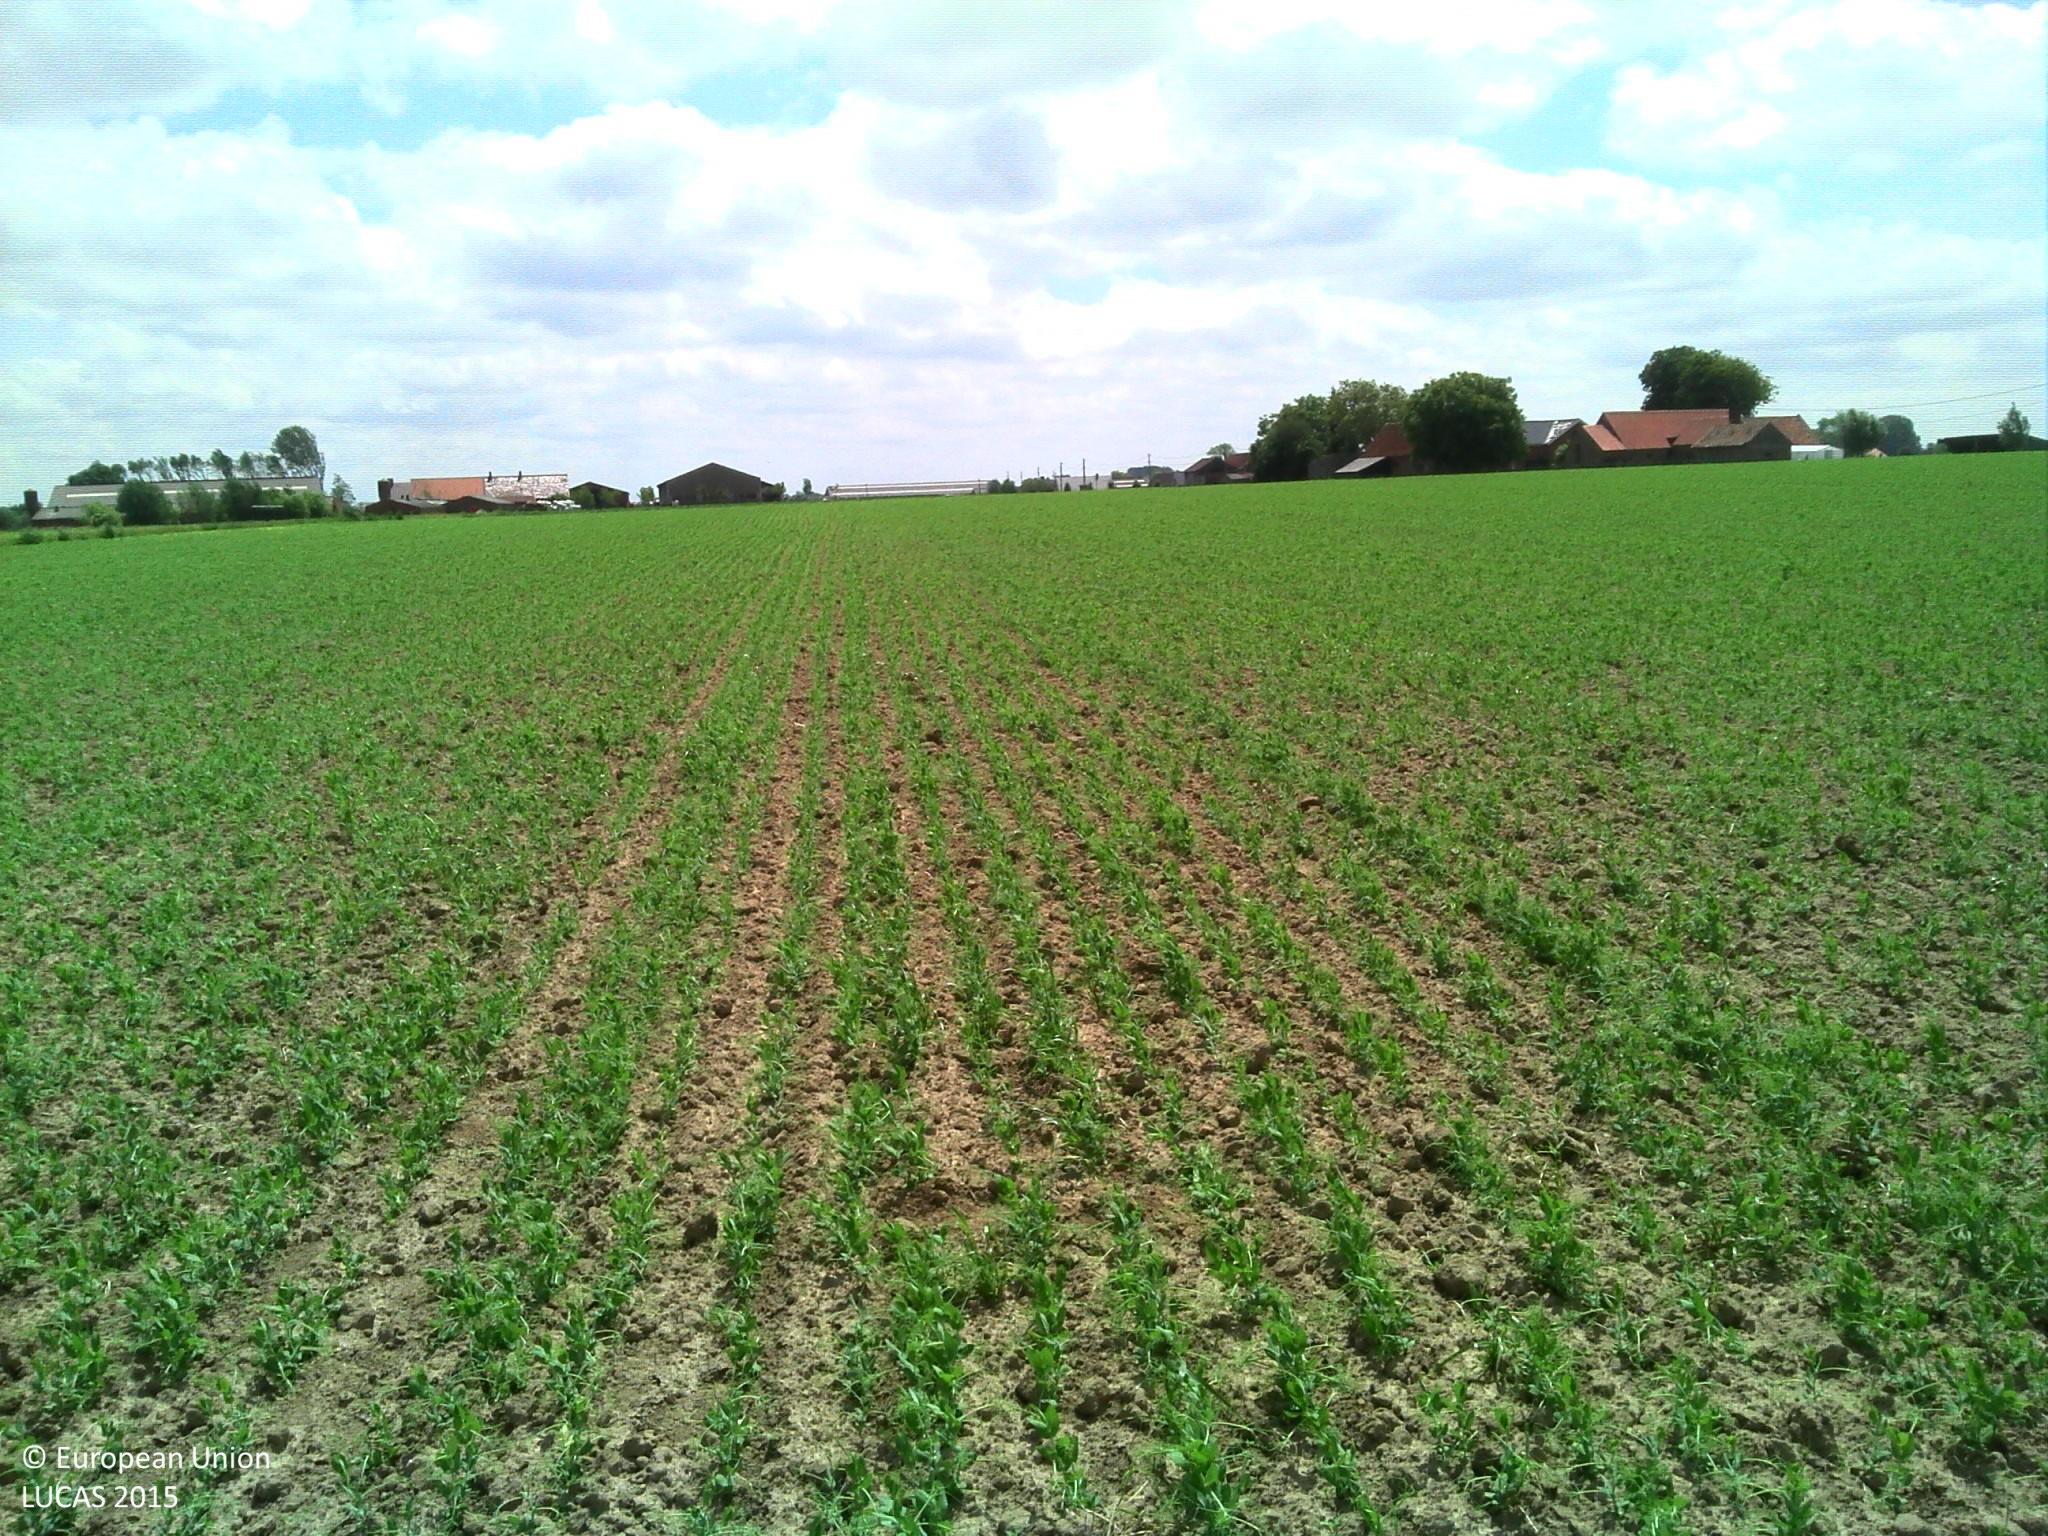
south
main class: Cropland
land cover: Dry pulses
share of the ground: 50 - 75 %
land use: Agriculture (excluding fallow land and kitchen gardens)
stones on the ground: < 10 %
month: June
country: BE
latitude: 51.0221
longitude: 3.1045
